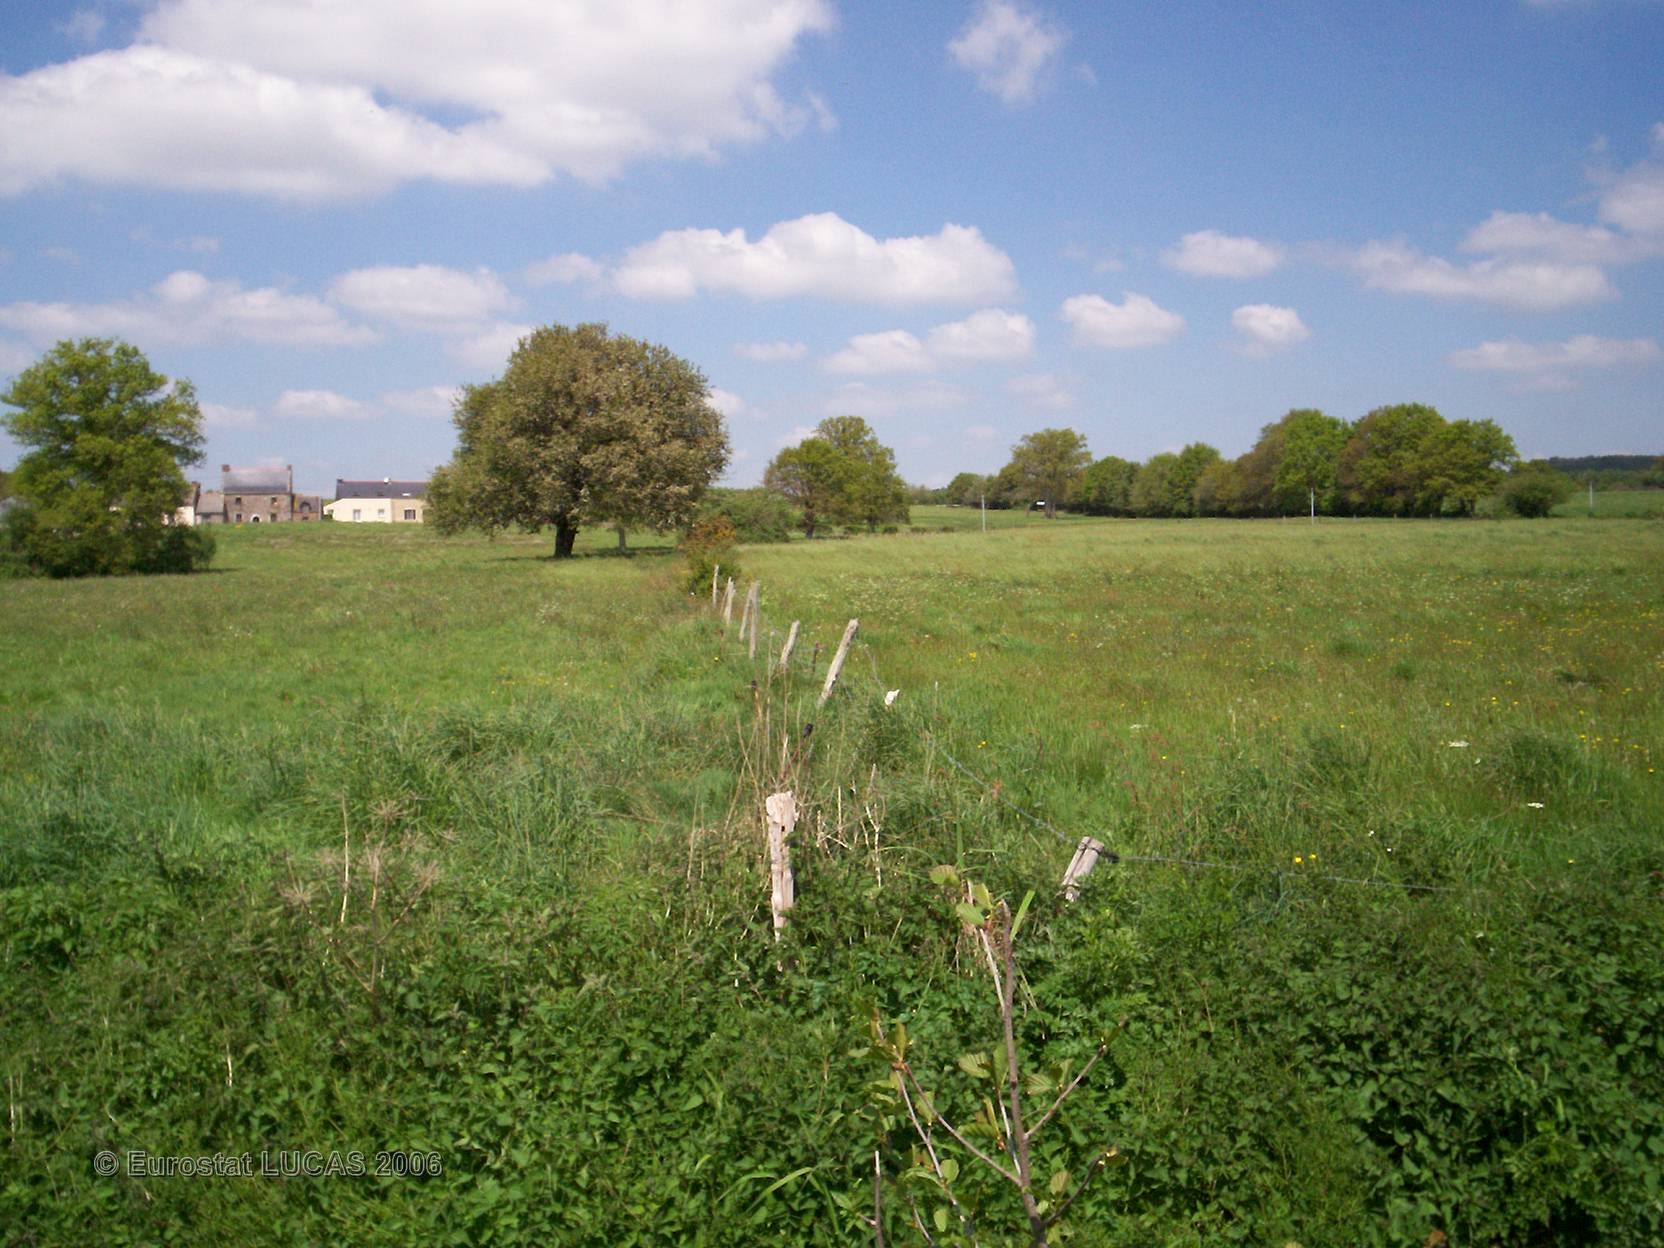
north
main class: Grassland
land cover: Grassland without tree/shrub cover
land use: Agriculture (excluding fallow land and kitchen gardens)
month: May
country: FR
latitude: 47.6099
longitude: -2.2526
